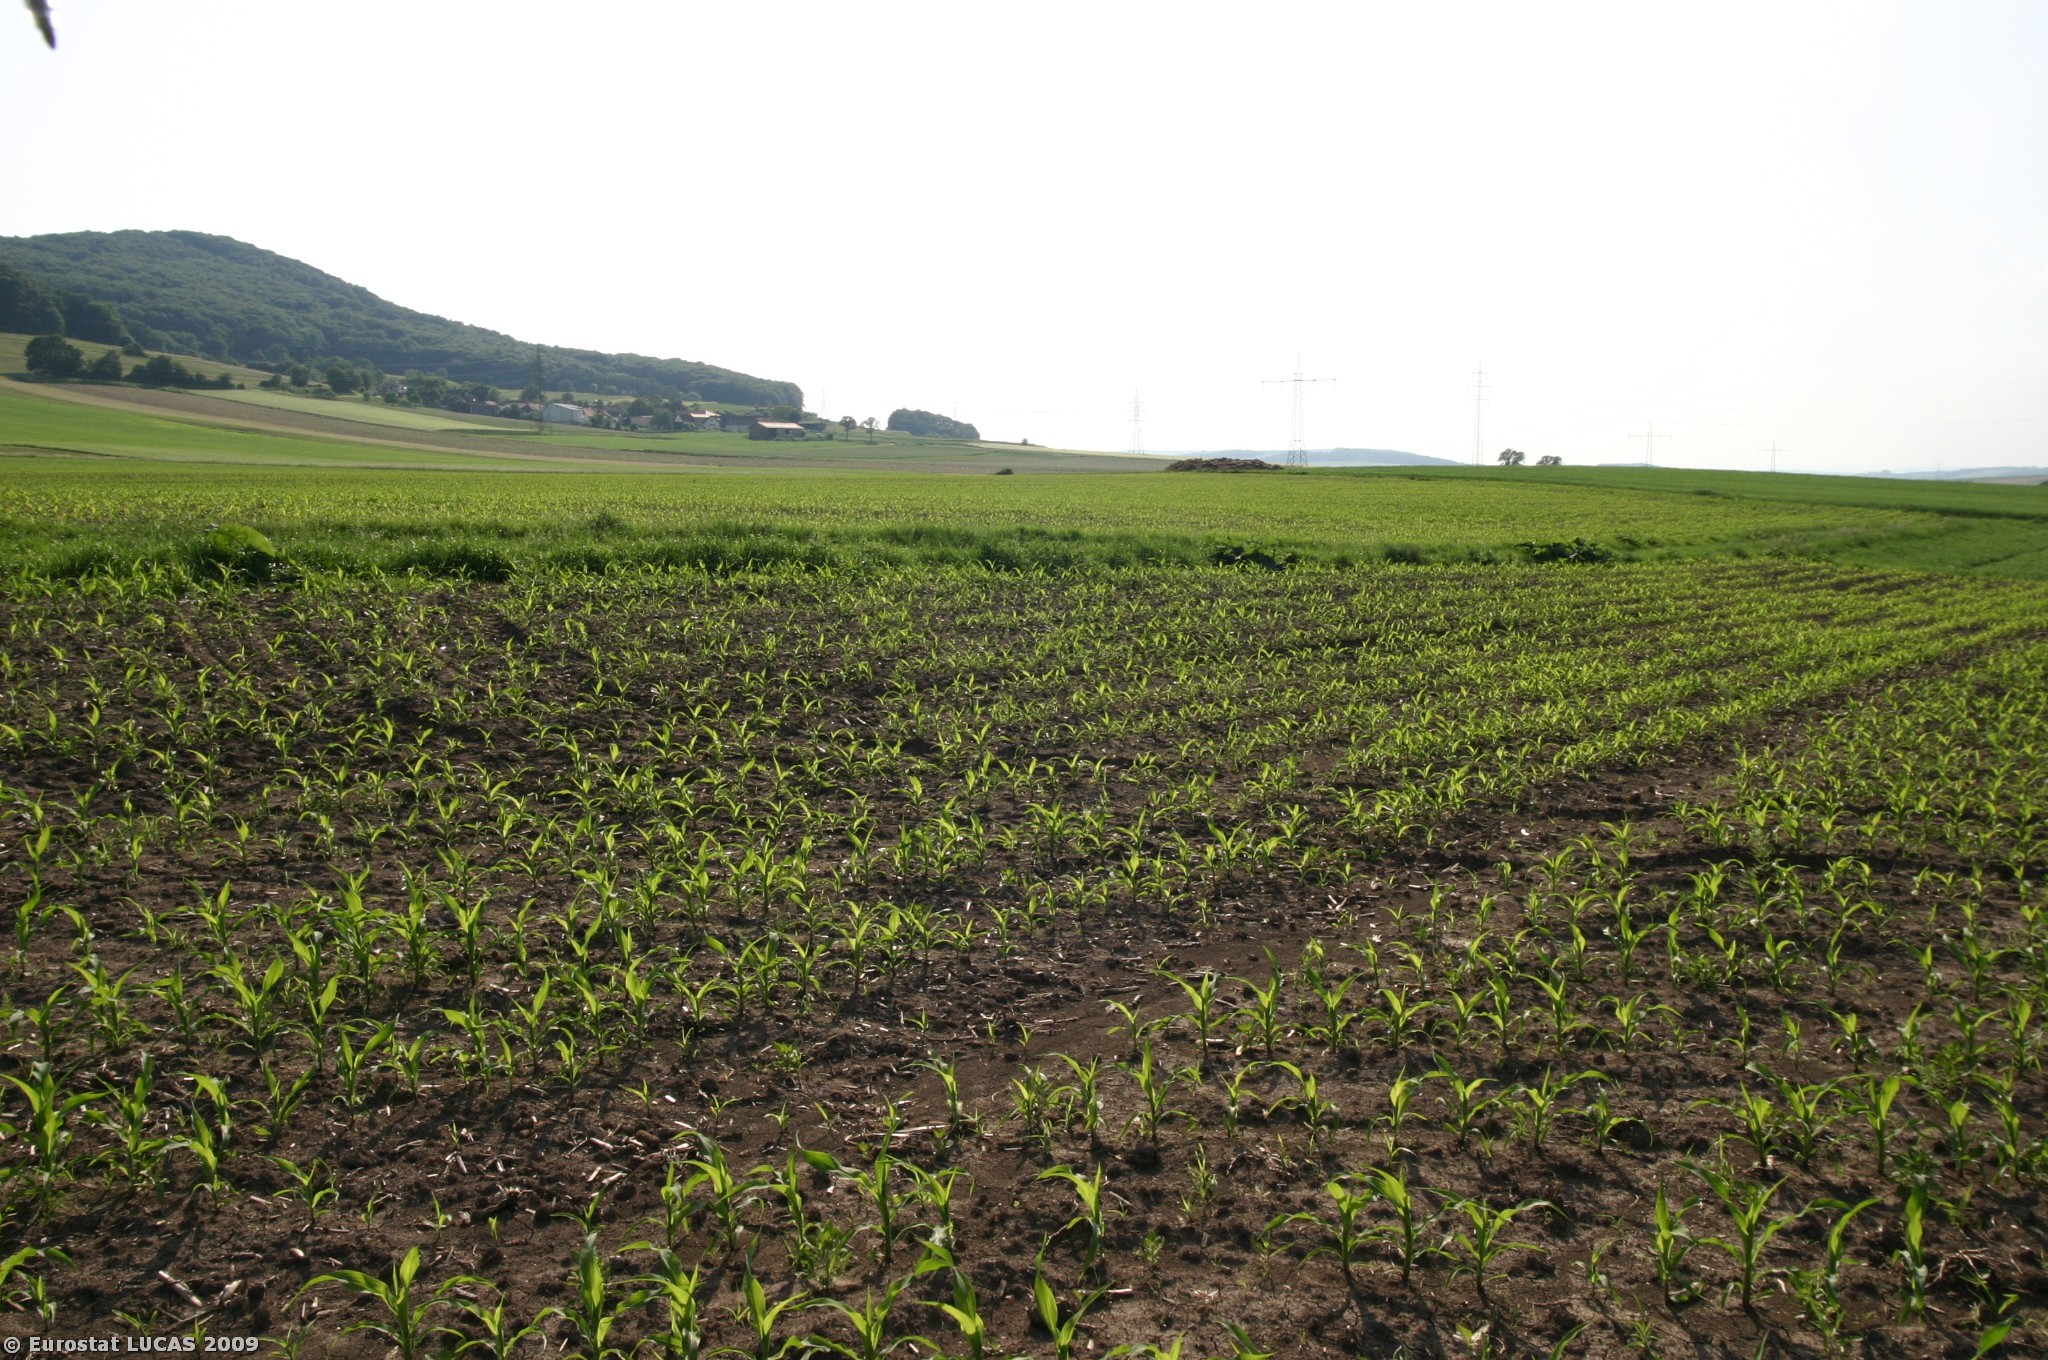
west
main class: Cropland
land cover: Maize
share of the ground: 10 - 25 %
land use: Agriculture (excluding fallow land and kitchen gardens)
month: May
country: AT
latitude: 48.2243
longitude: 15.9669
